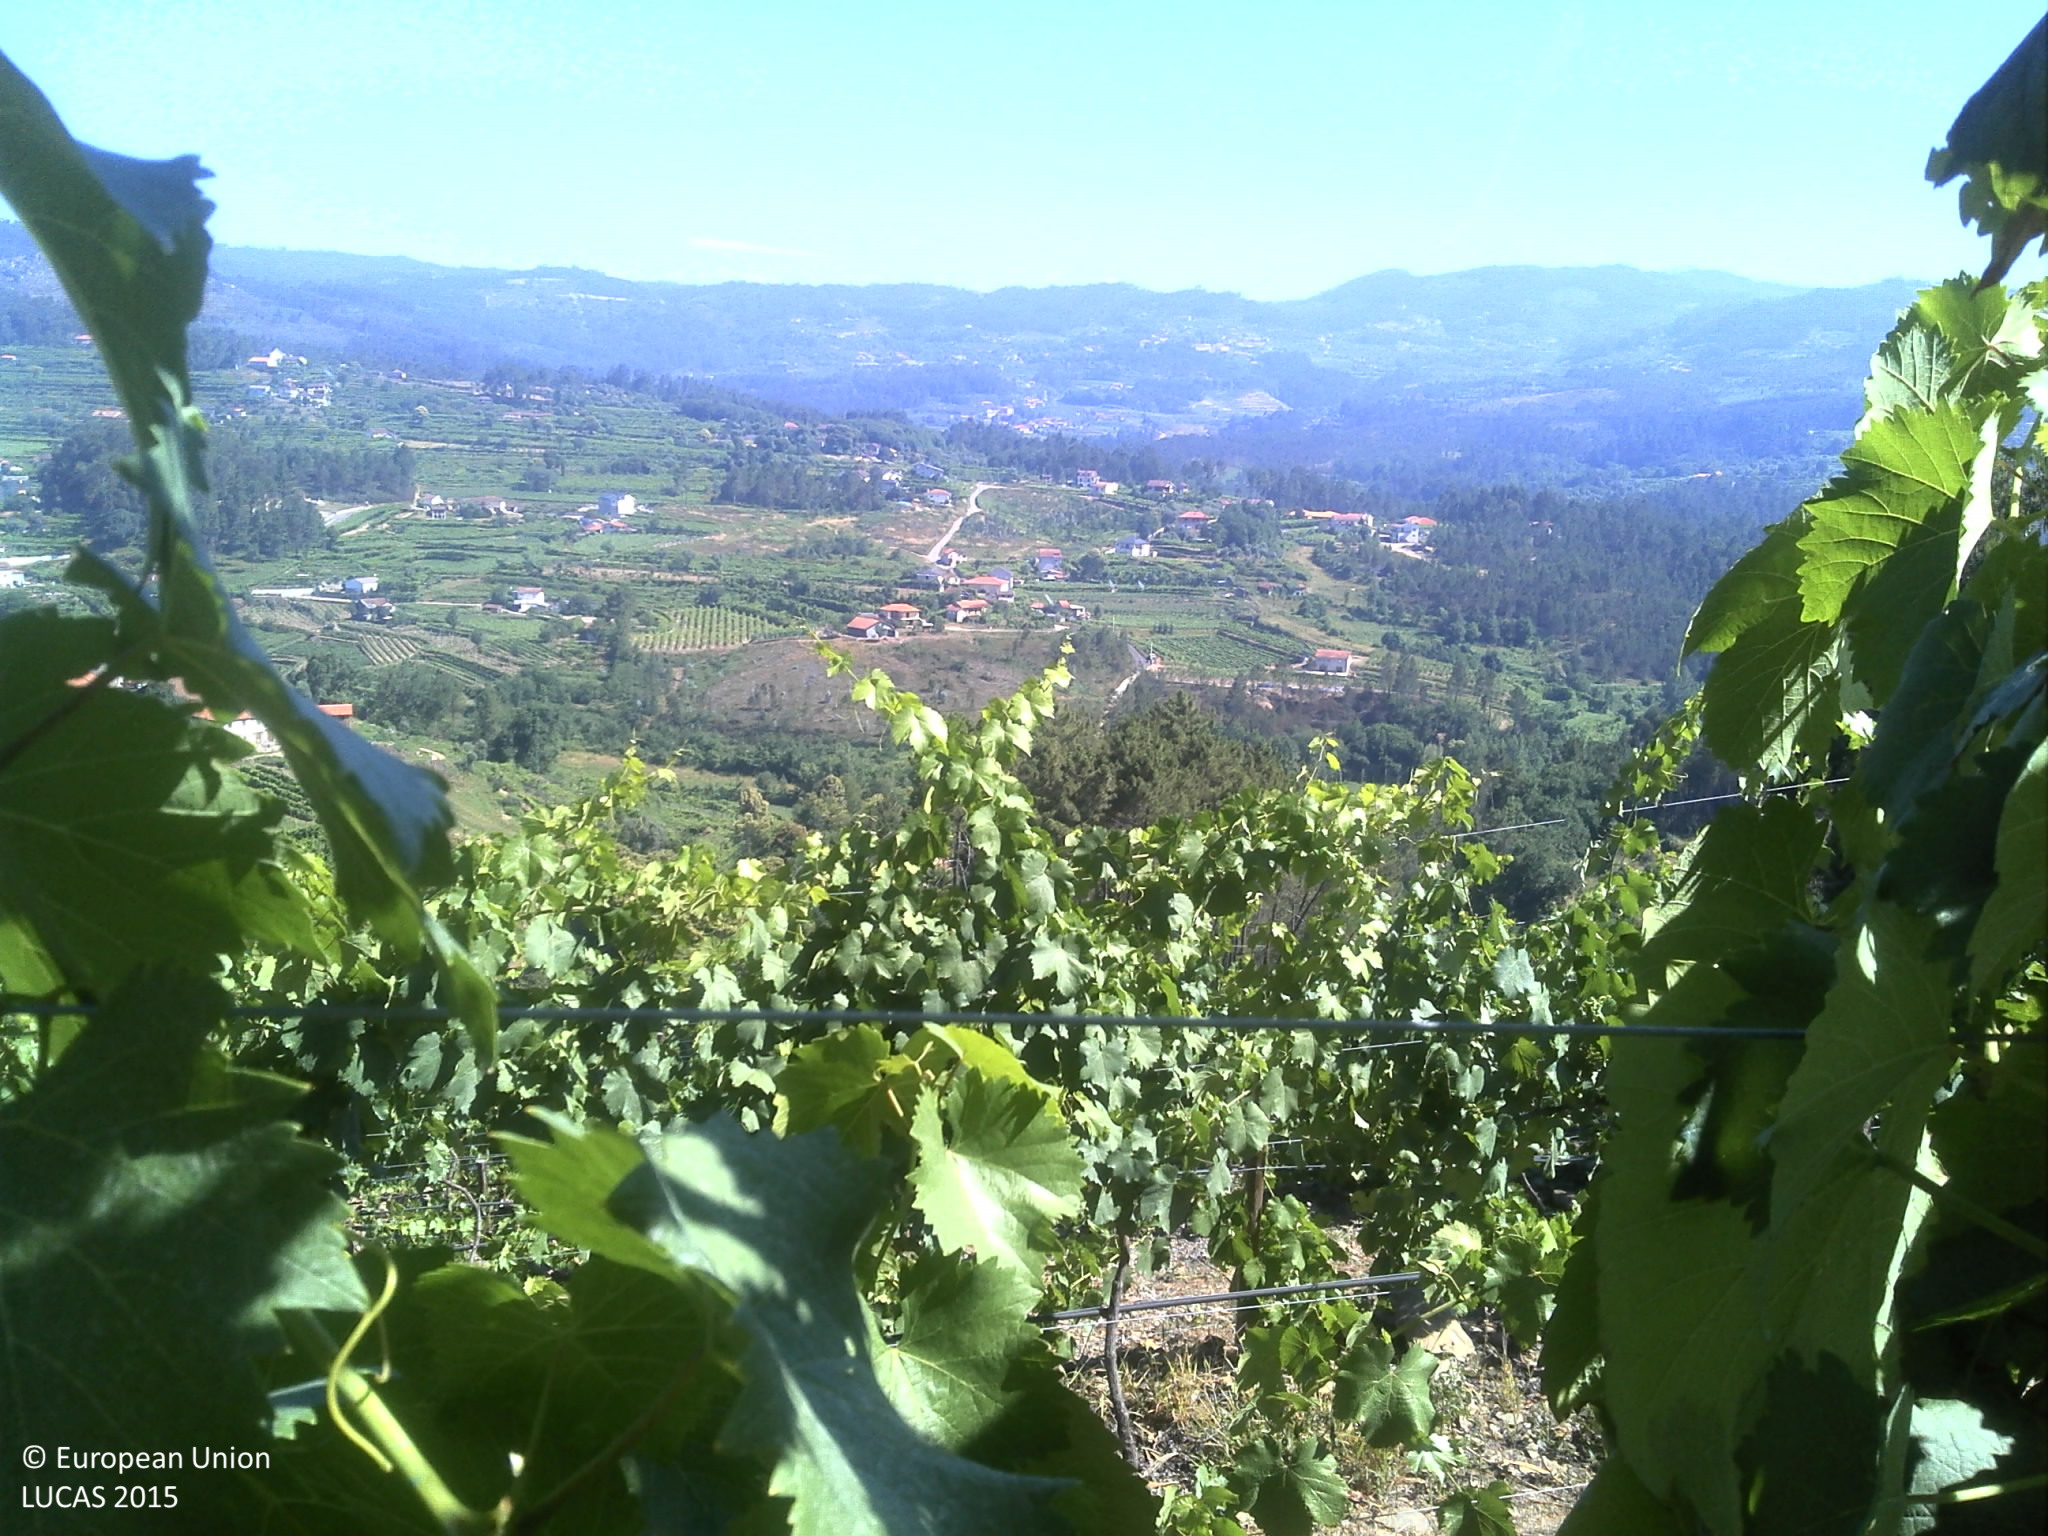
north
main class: Cropland
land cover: Vineyards
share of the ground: 25 - 50 %
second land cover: Grassland without tree/shrub cover
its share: 10 - 25 %
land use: Agriculture (excluding fallow land and kitchen gardens)
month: June
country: PT
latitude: 41.3217
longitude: -8.0966
